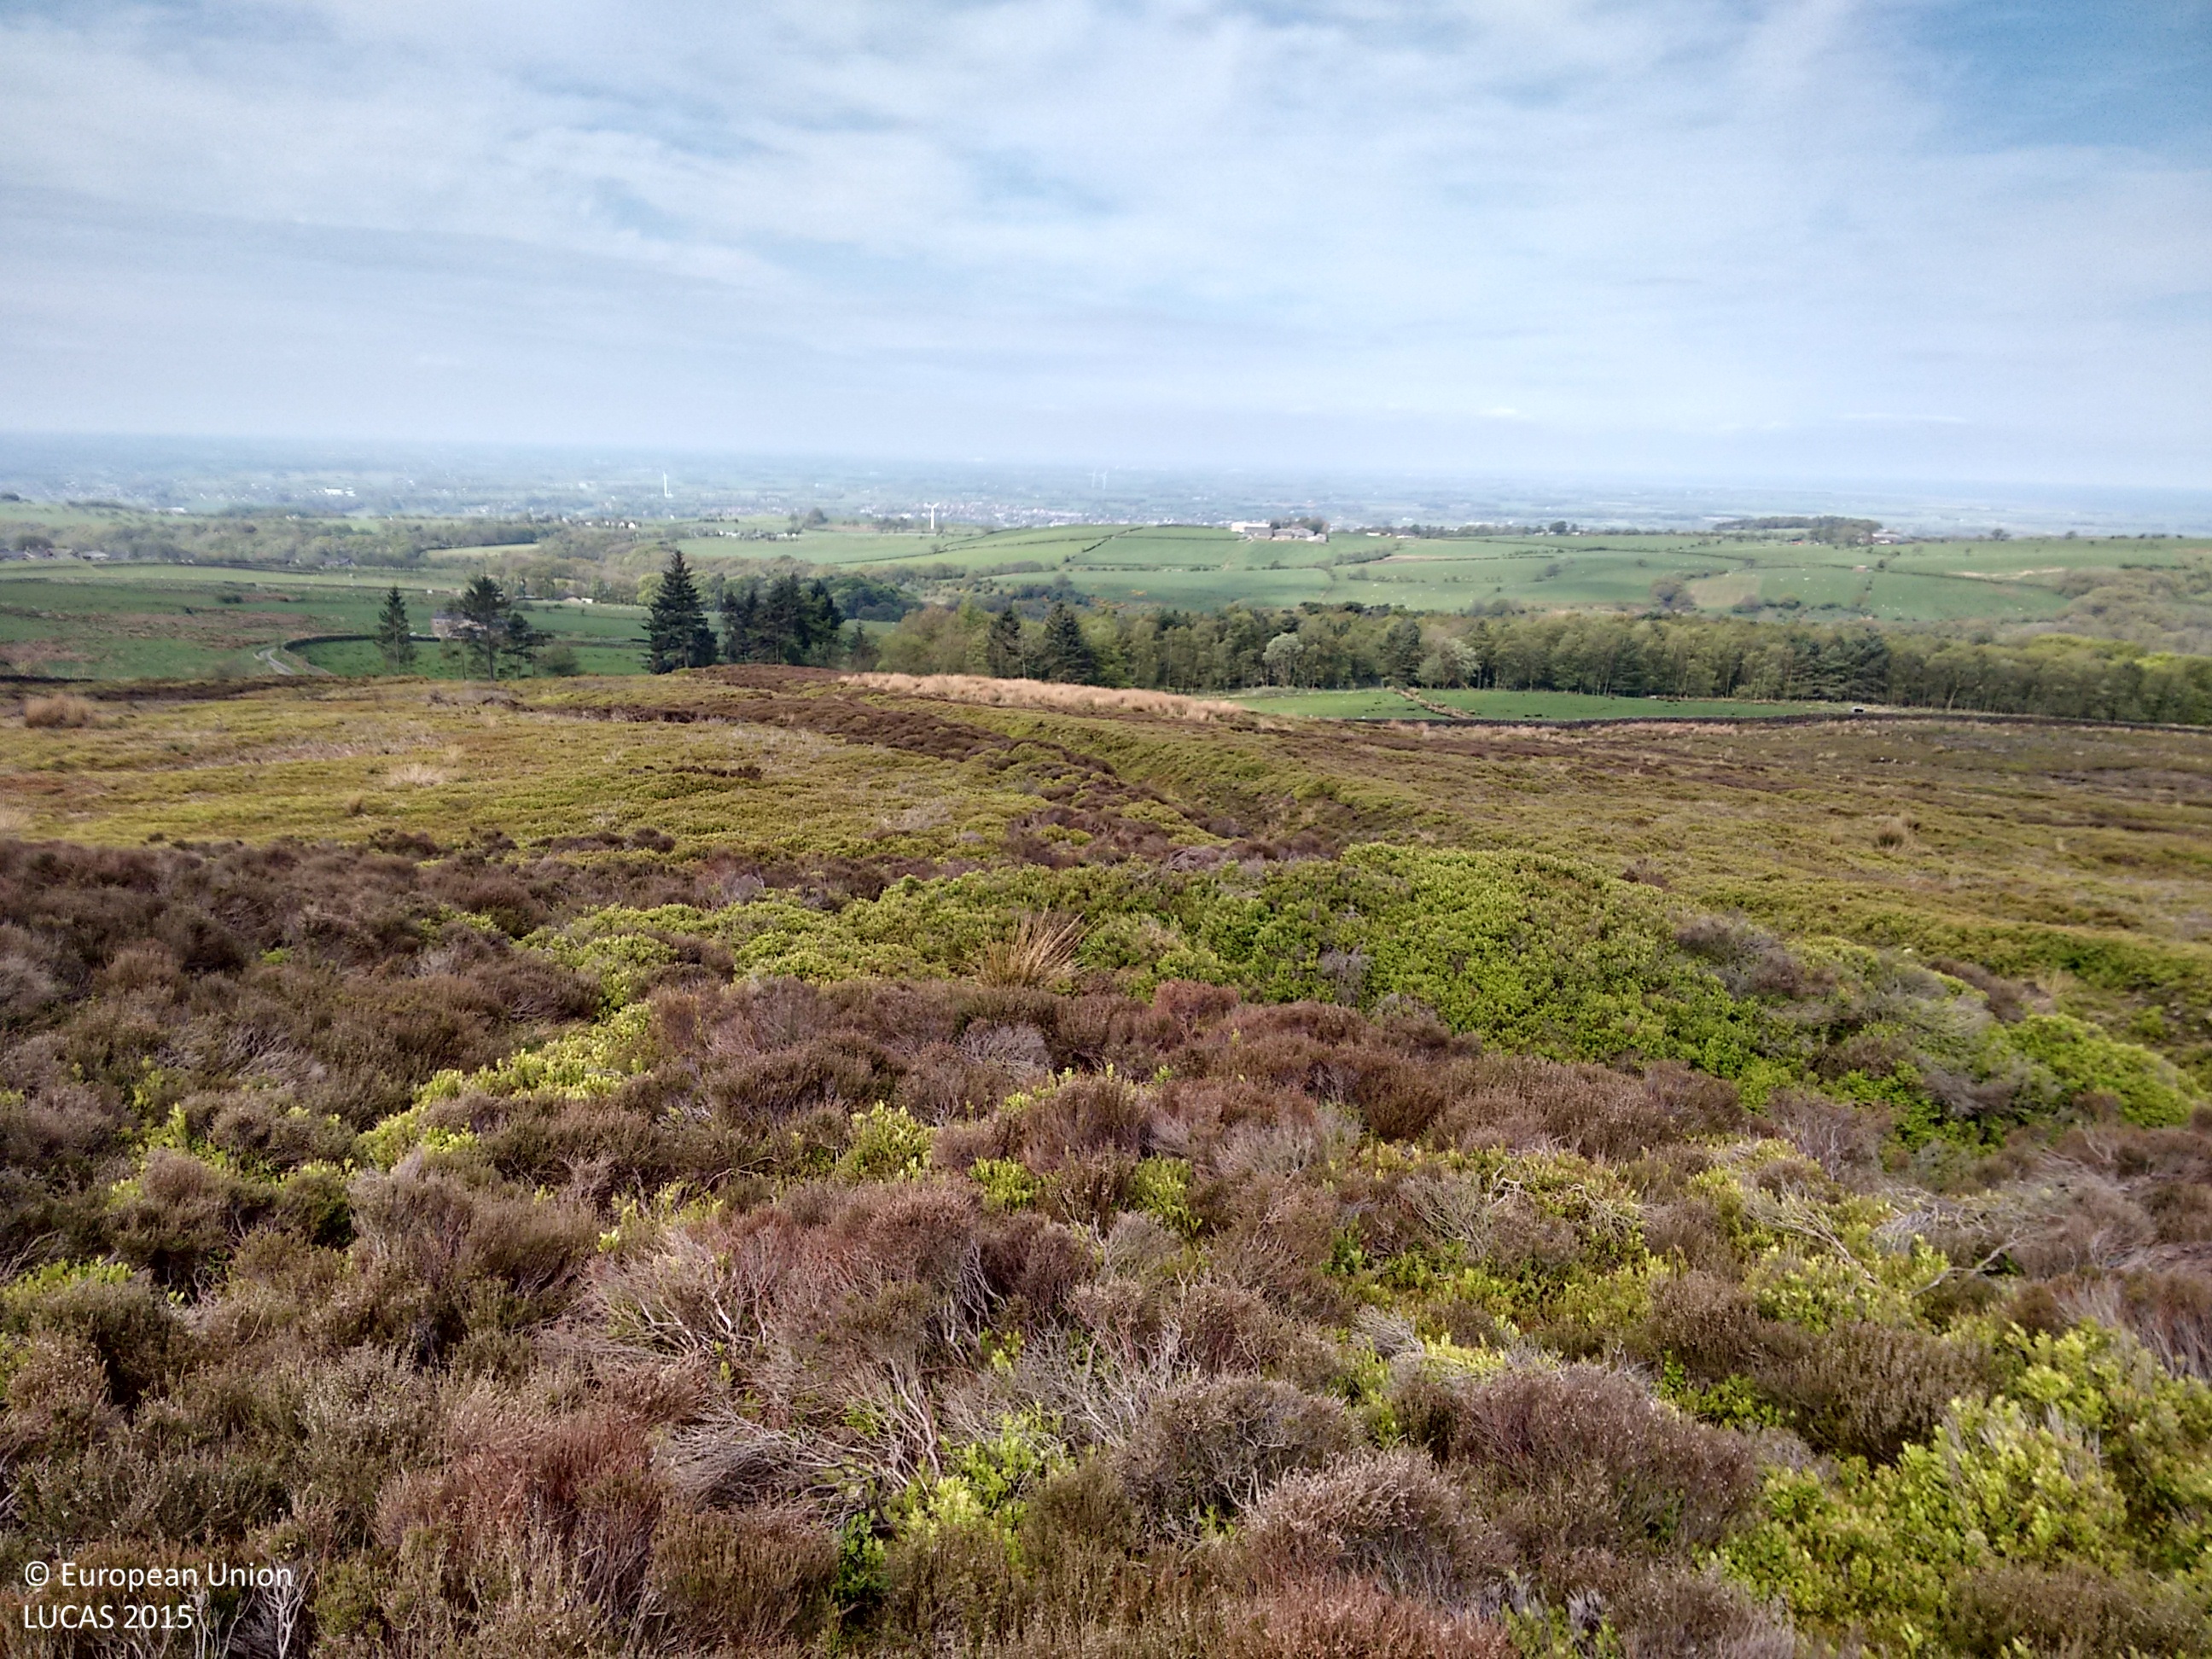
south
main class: Shrubland
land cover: Shrubland without tree cover
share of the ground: > 75 %
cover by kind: shrubs 100 %
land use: Agriculture (excluding fallow land and kitchen gardens)
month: May
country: GB
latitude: 53.9148
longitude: -2.6892
